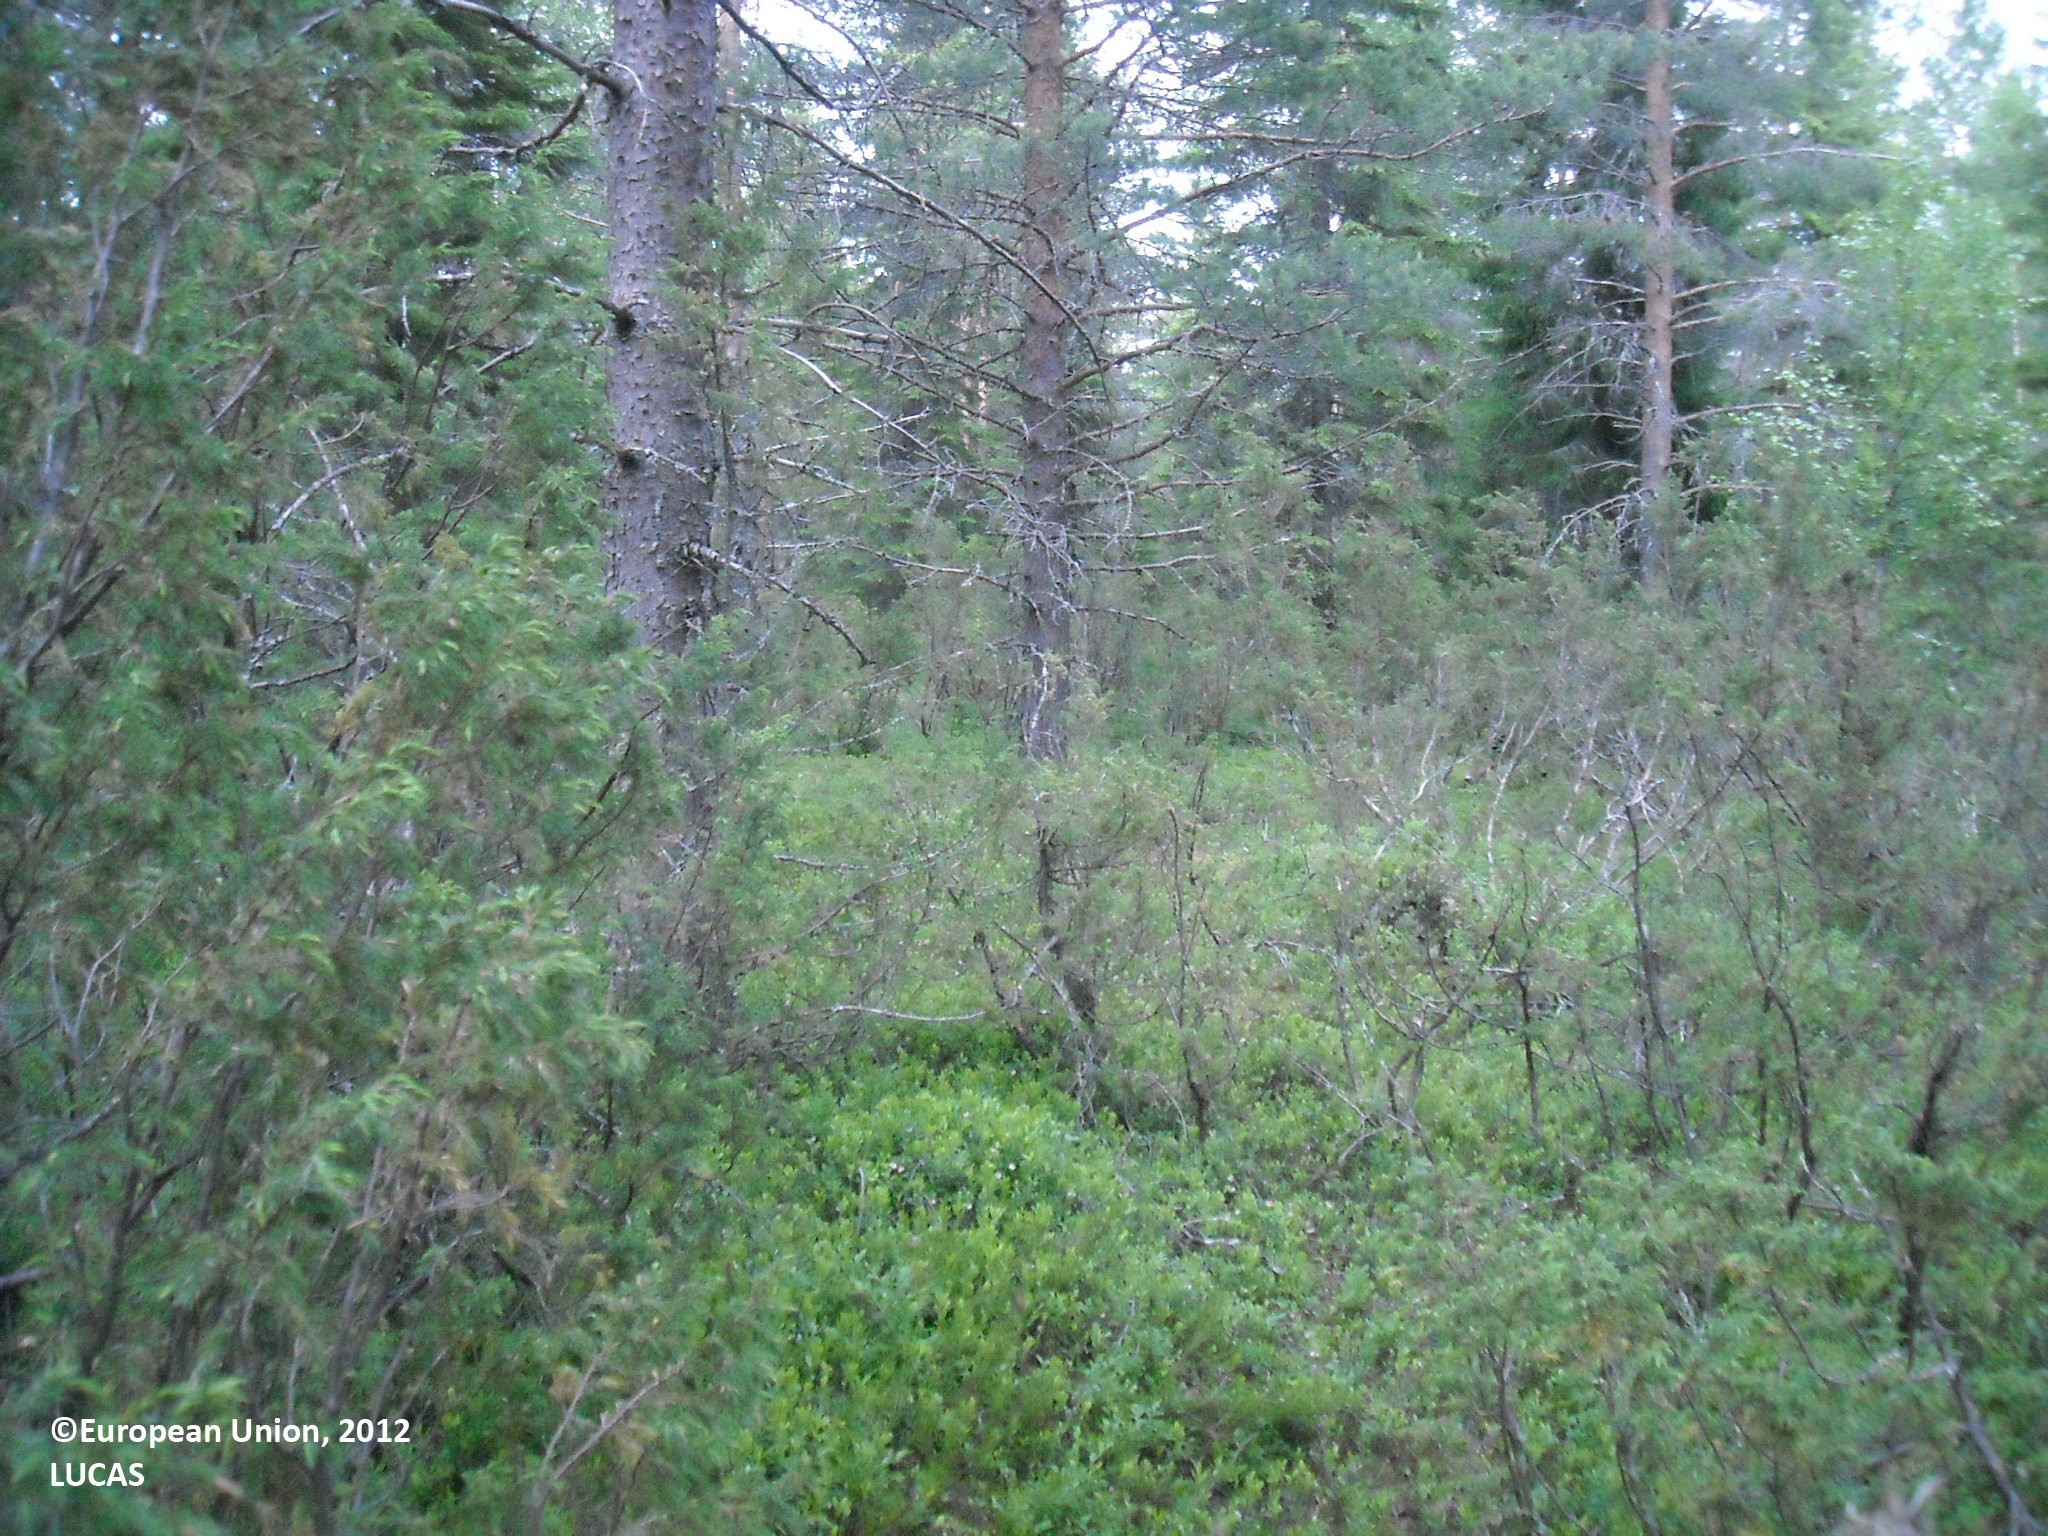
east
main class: Woodland
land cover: Other coniferous woodland
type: boreal forest
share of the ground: > 75 %
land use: Forestry
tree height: > 5 m
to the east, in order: Other coniferous woodland; Tracks; Other coniferous woodland; Pine dominated coniferous woodland
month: July
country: FI
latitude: 64.6112
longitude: 27.7718
